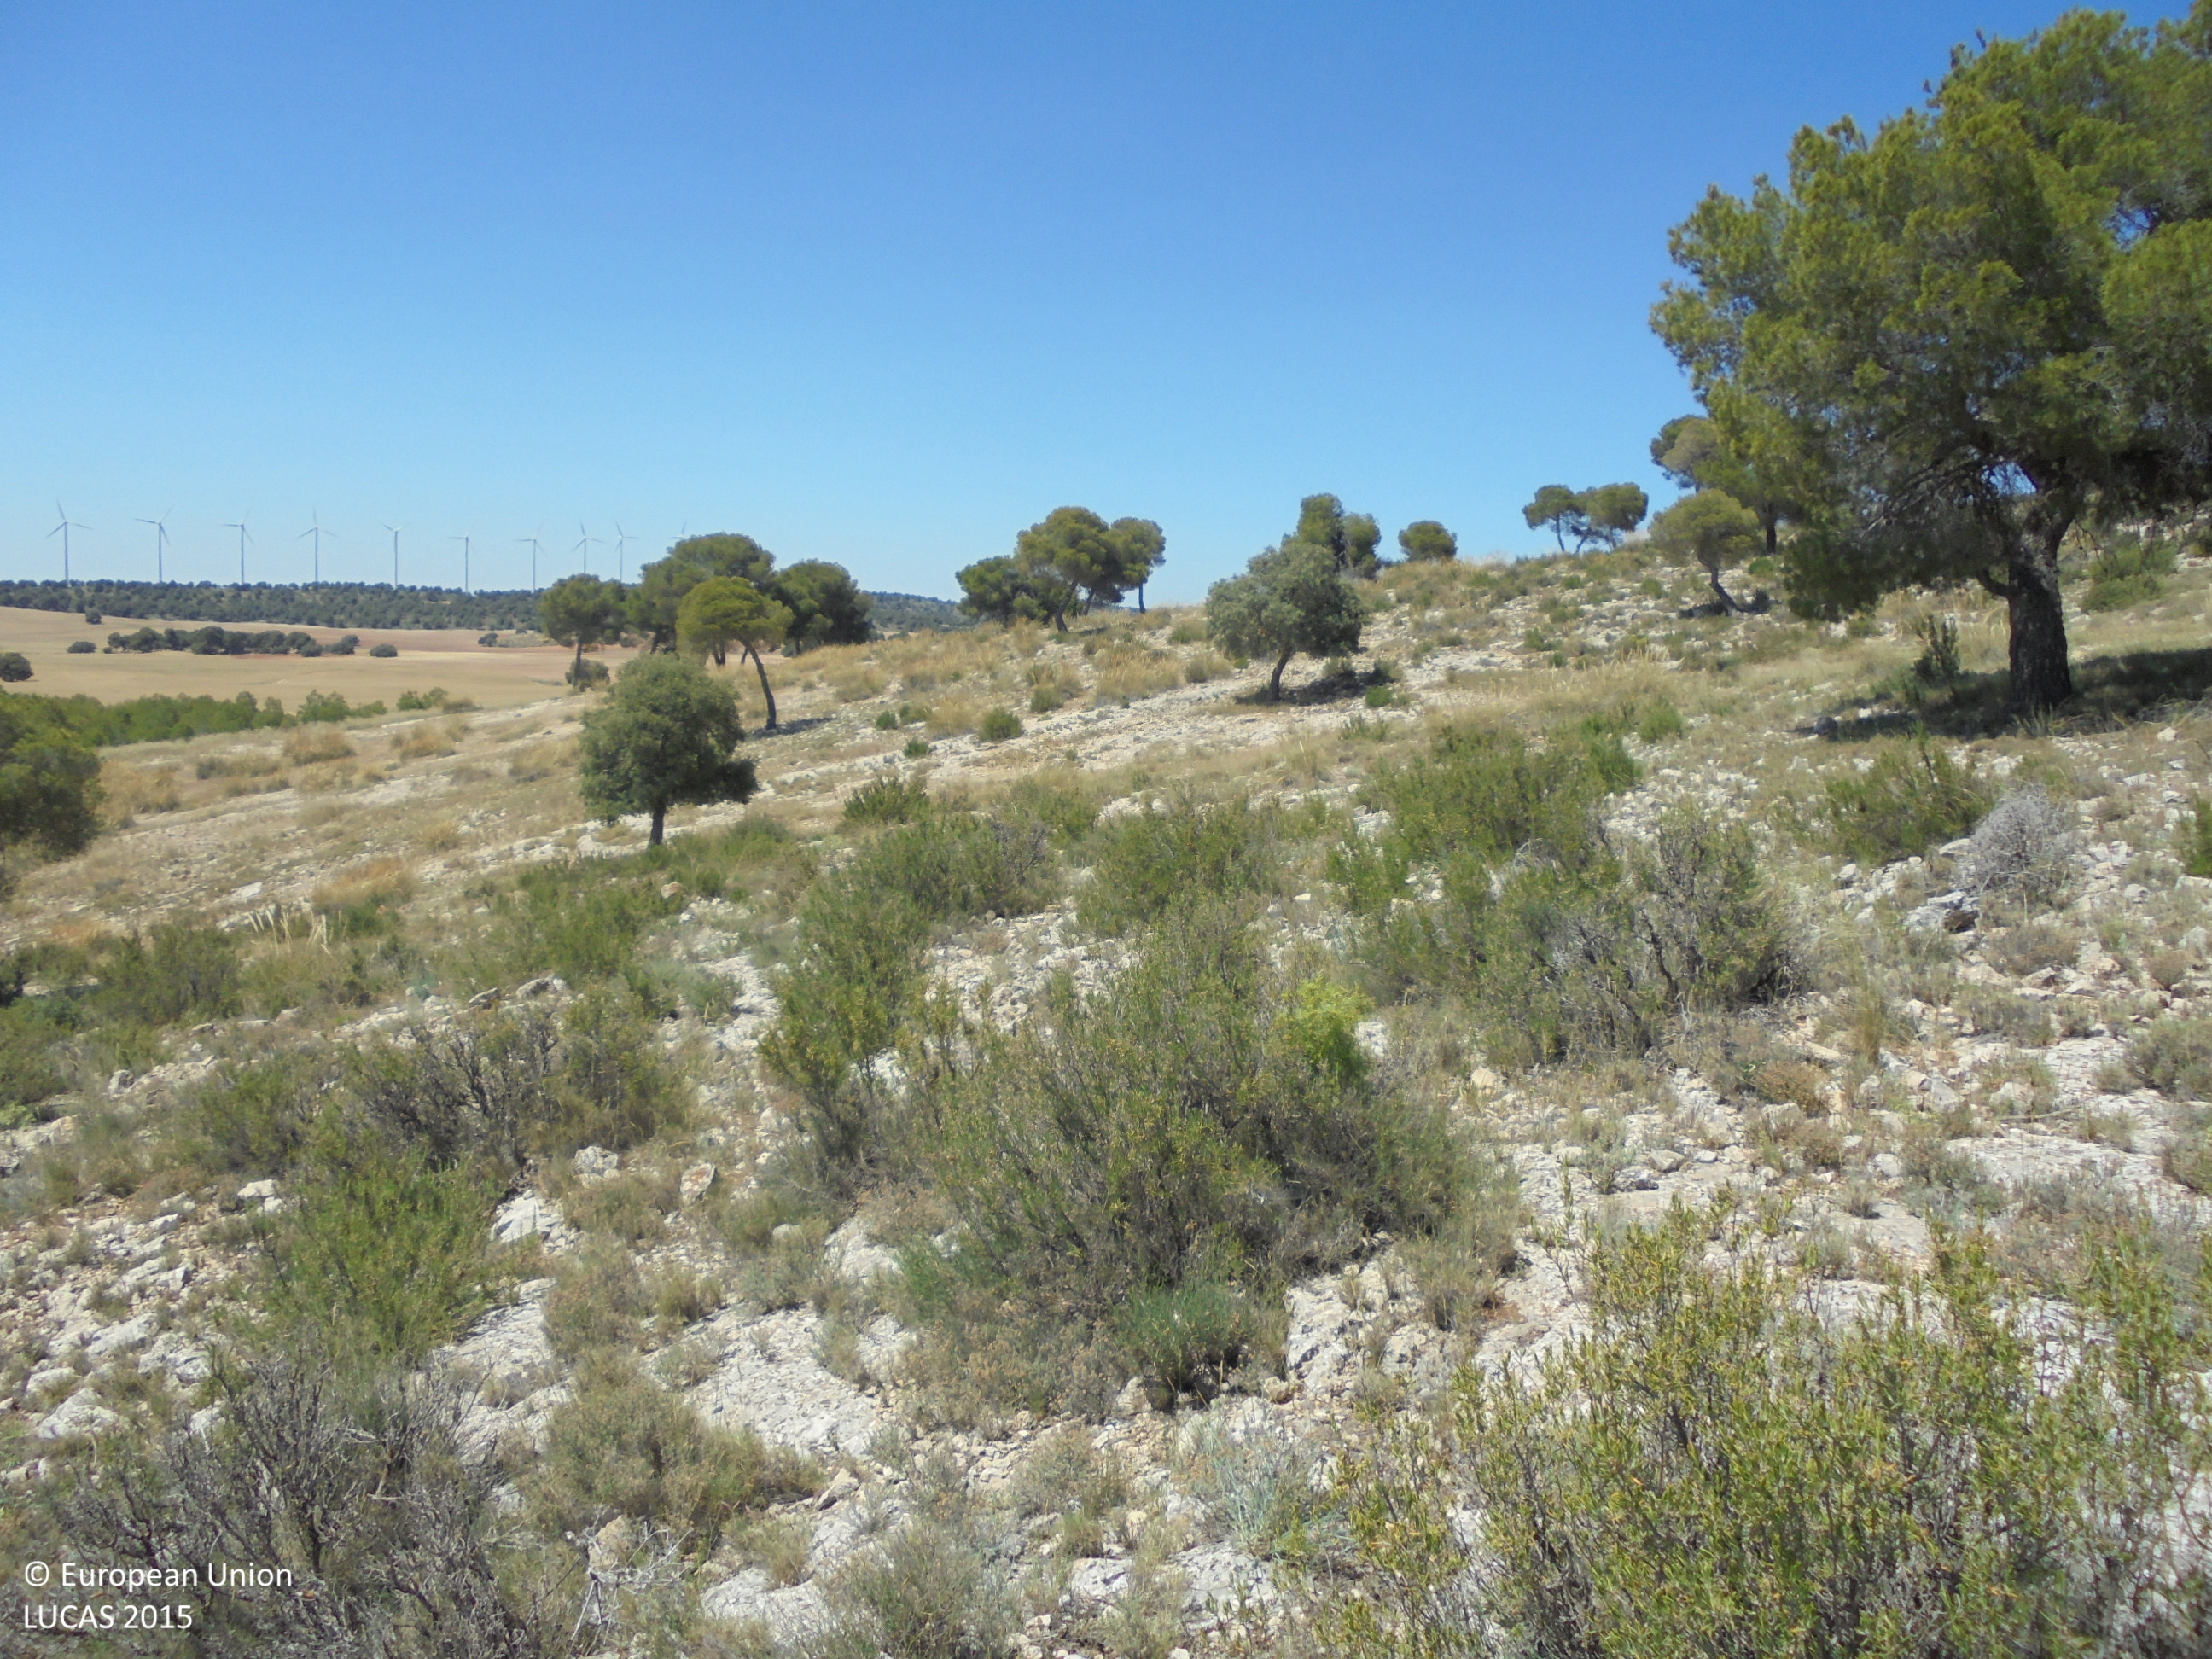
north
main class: Woodland
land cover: Pine dominated coniferous woodland
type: coniferous forest of the mediterranean region
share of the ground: 10 - 25 %
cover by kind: shrubs 35 %, unconsolidated bare surface 25 %, coniferous forest trees 20 %, herbaceous plants 10 %, consolidated bare surface 10 %
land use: Semi-natural and natural areas not in use
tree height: > 5 m
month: June
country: ES
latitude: 38.7993
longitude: -1.6838
